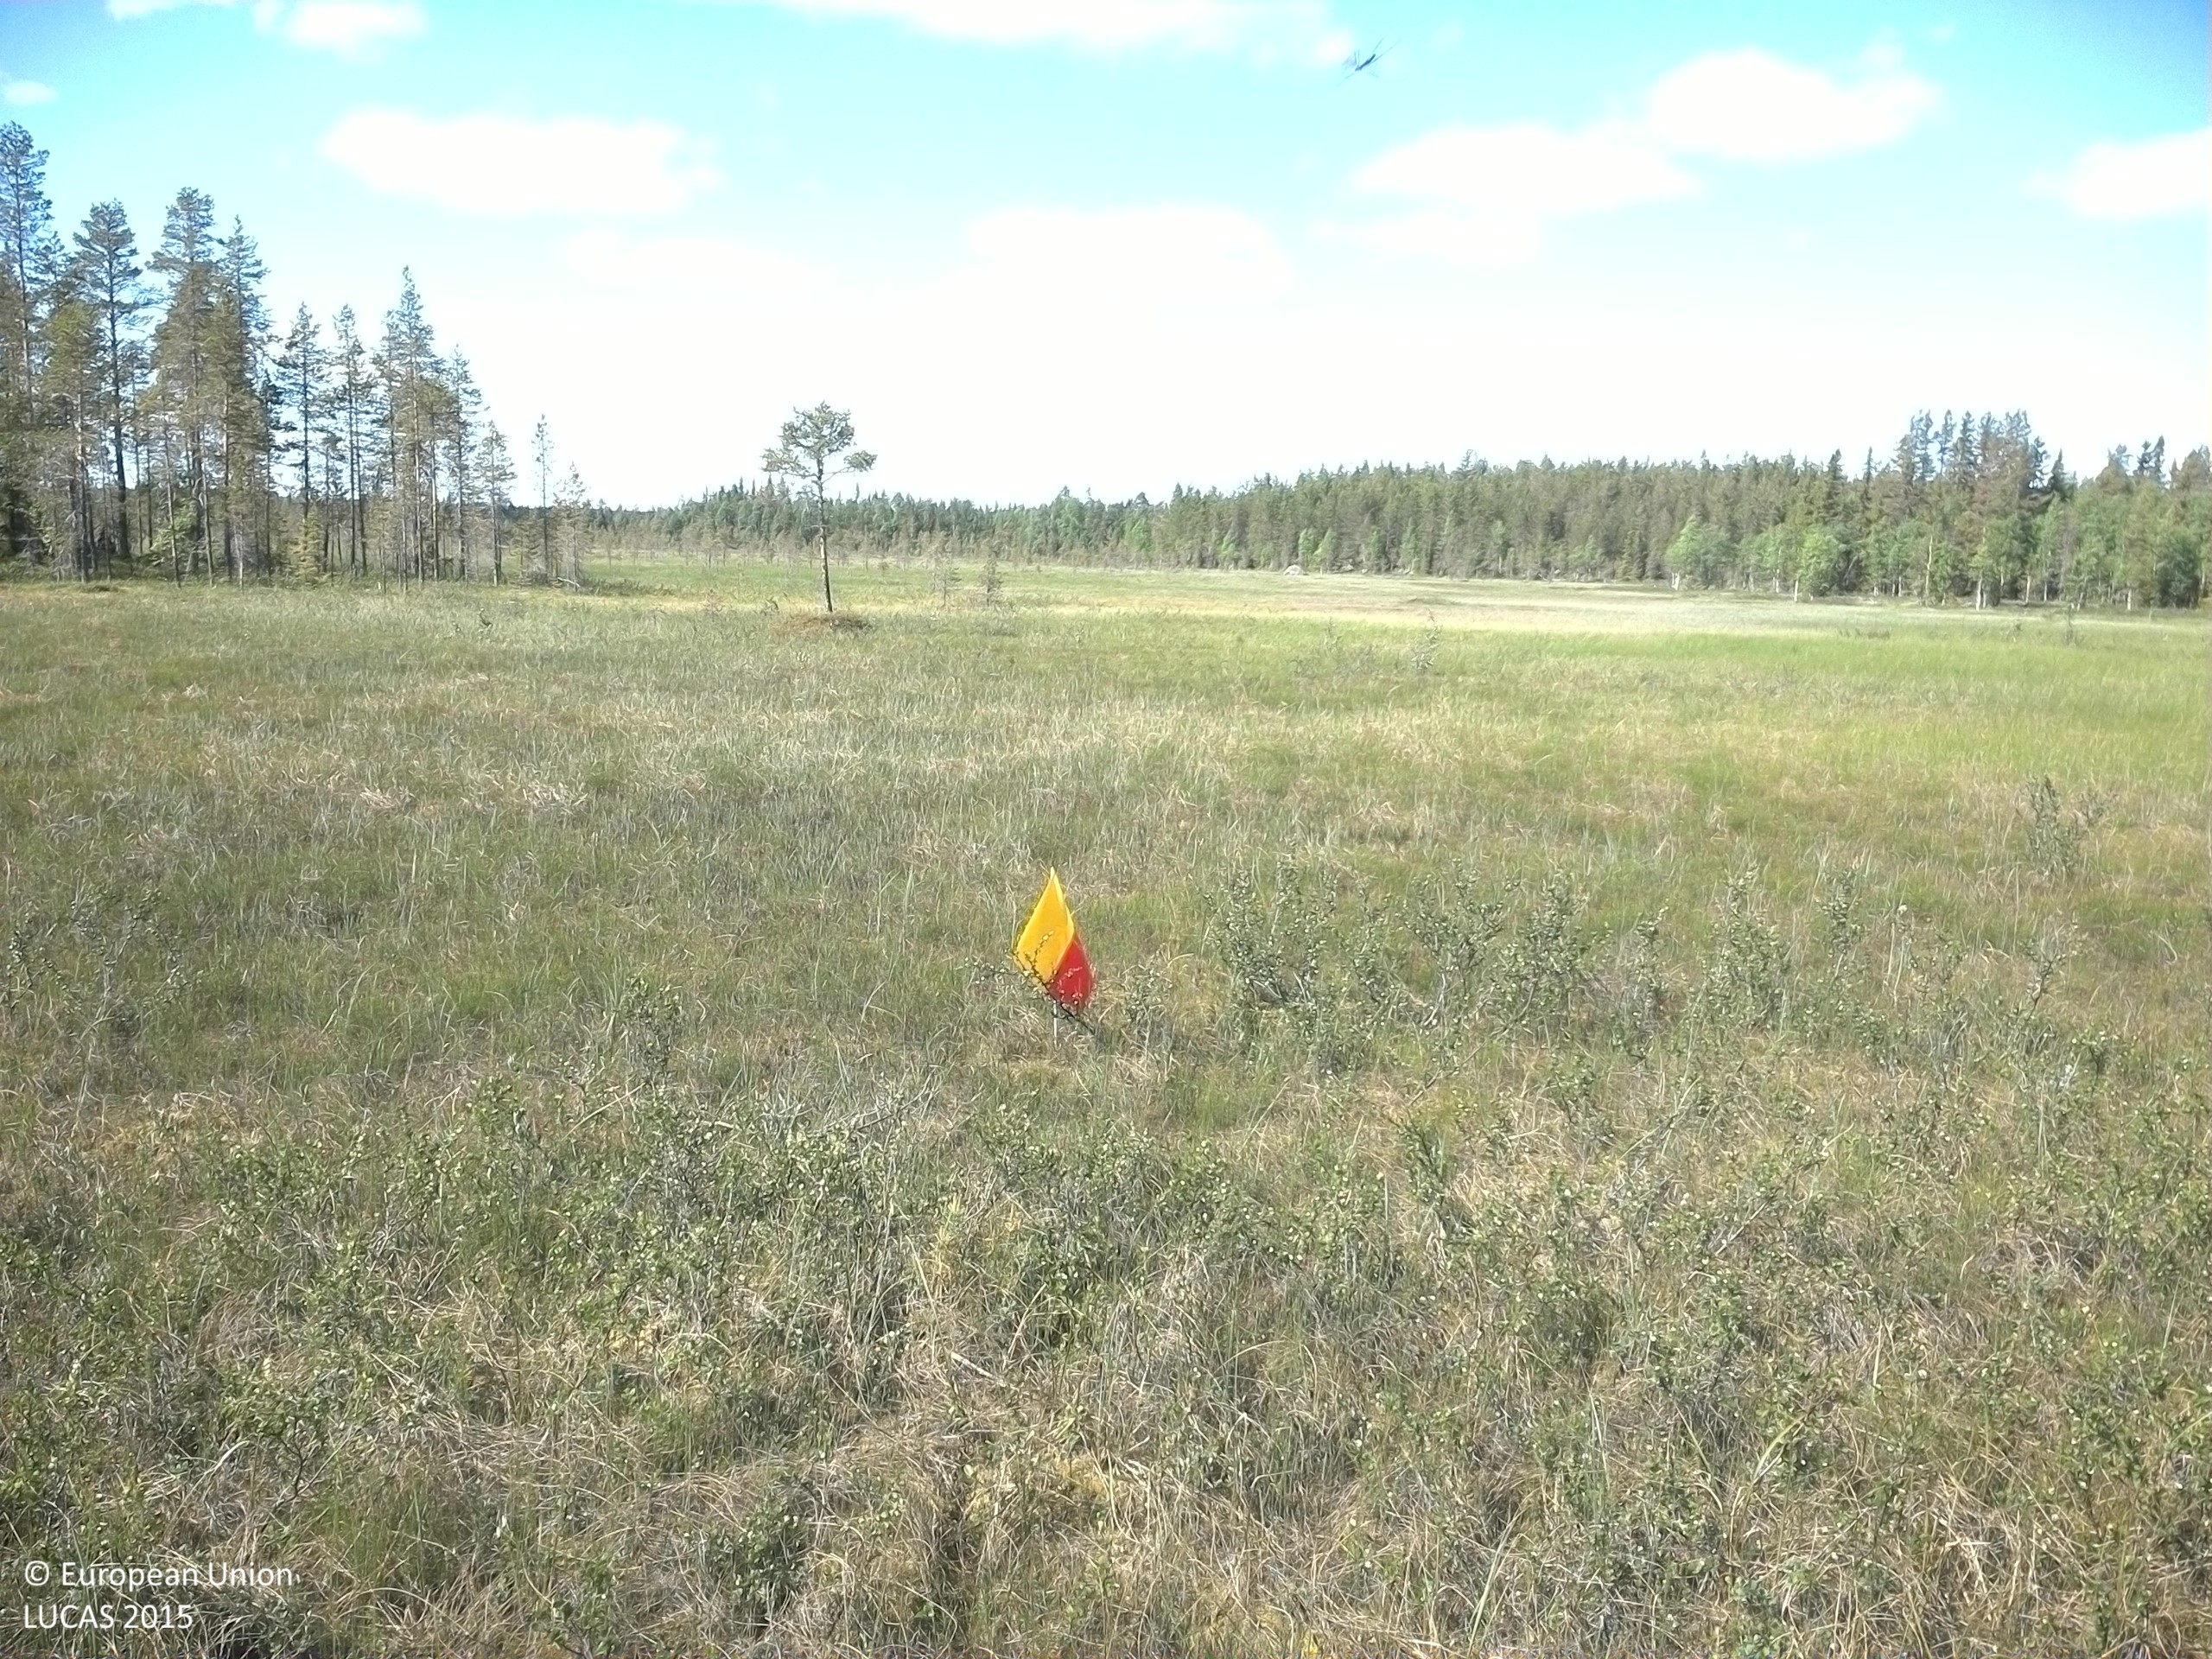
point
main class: Grassland
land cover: Grassland with sparse tree/shrub cover
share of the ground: 50 - 75 %
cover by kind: herbaceous plants 60 %, lichens and mosses 30 %, broadleaved forest trees 5 %, shrubs 5 %
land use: Semi-natural and natural areas not in use
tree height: < 5 m
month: July
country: SE
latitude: 64.3098
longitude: 16.7295
